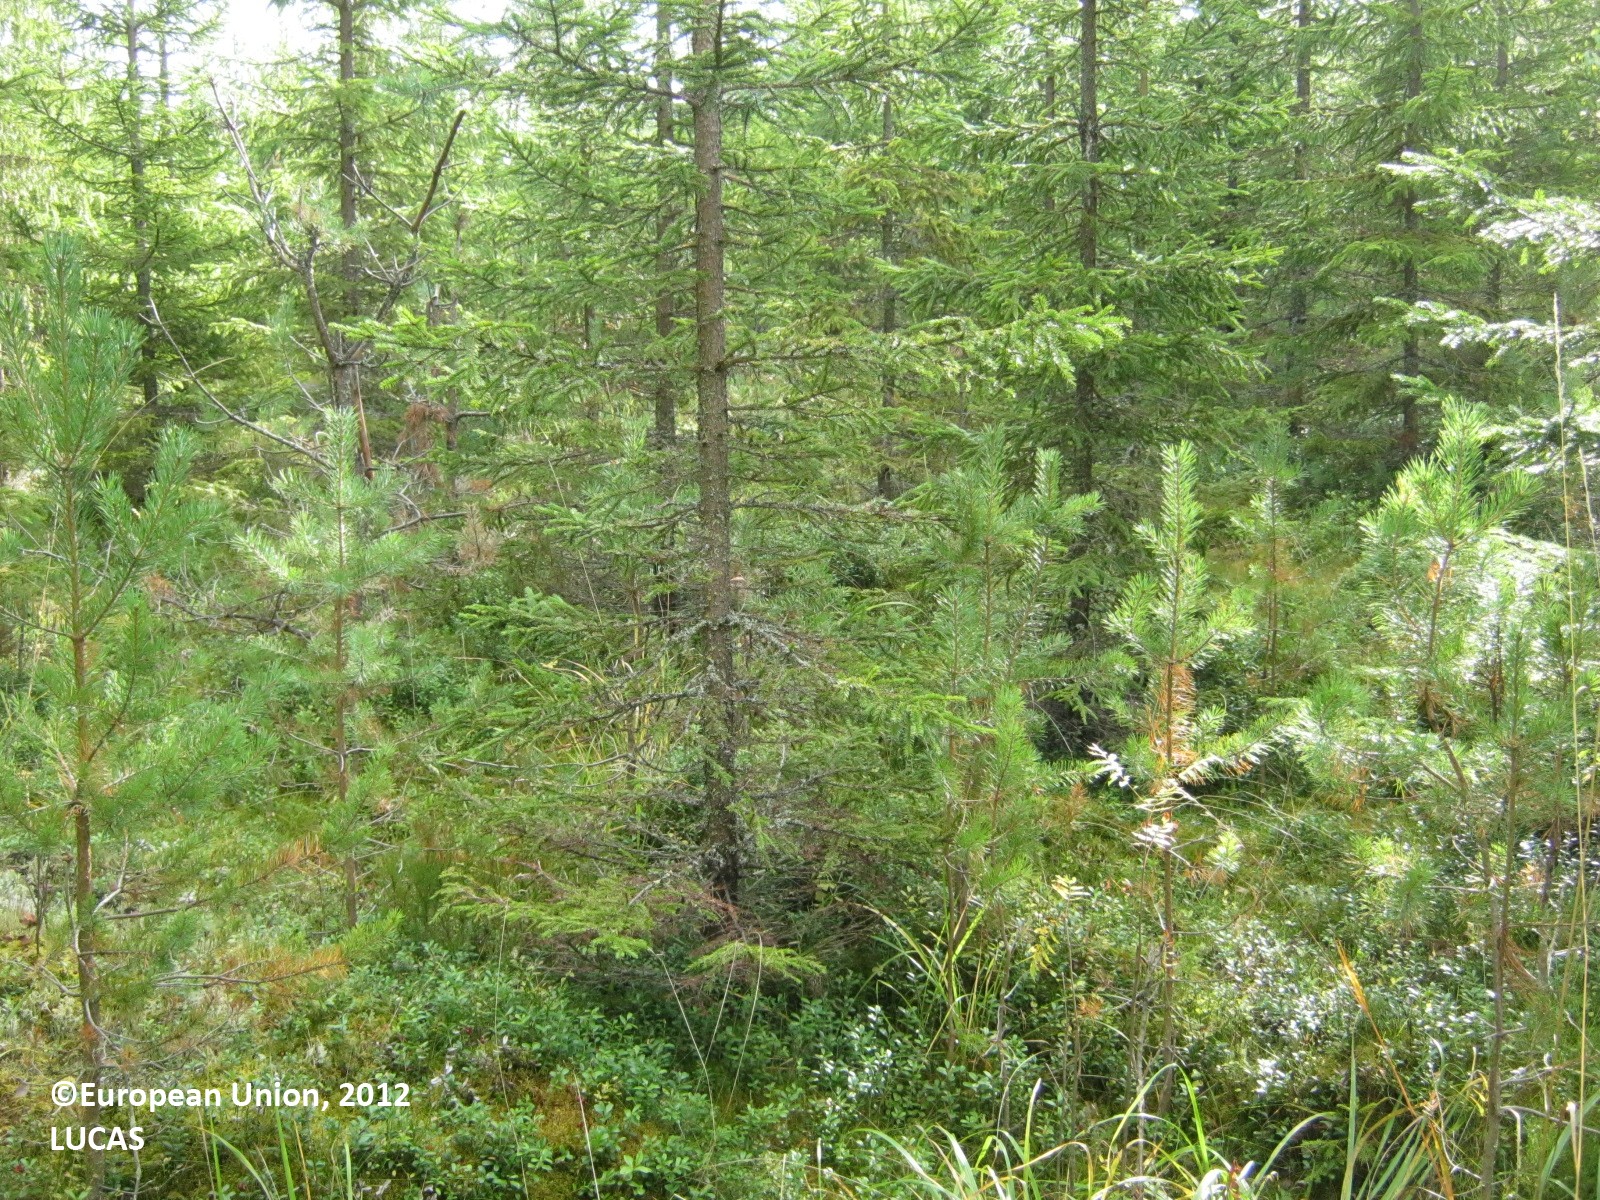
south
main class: Woodland
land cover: Spruce dominated coniferous woodland
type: boreal forest
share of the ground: > 75 %
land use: Forestry
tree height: > 5 m
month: September
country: FI
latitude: 62.2526
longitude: 28.9143
